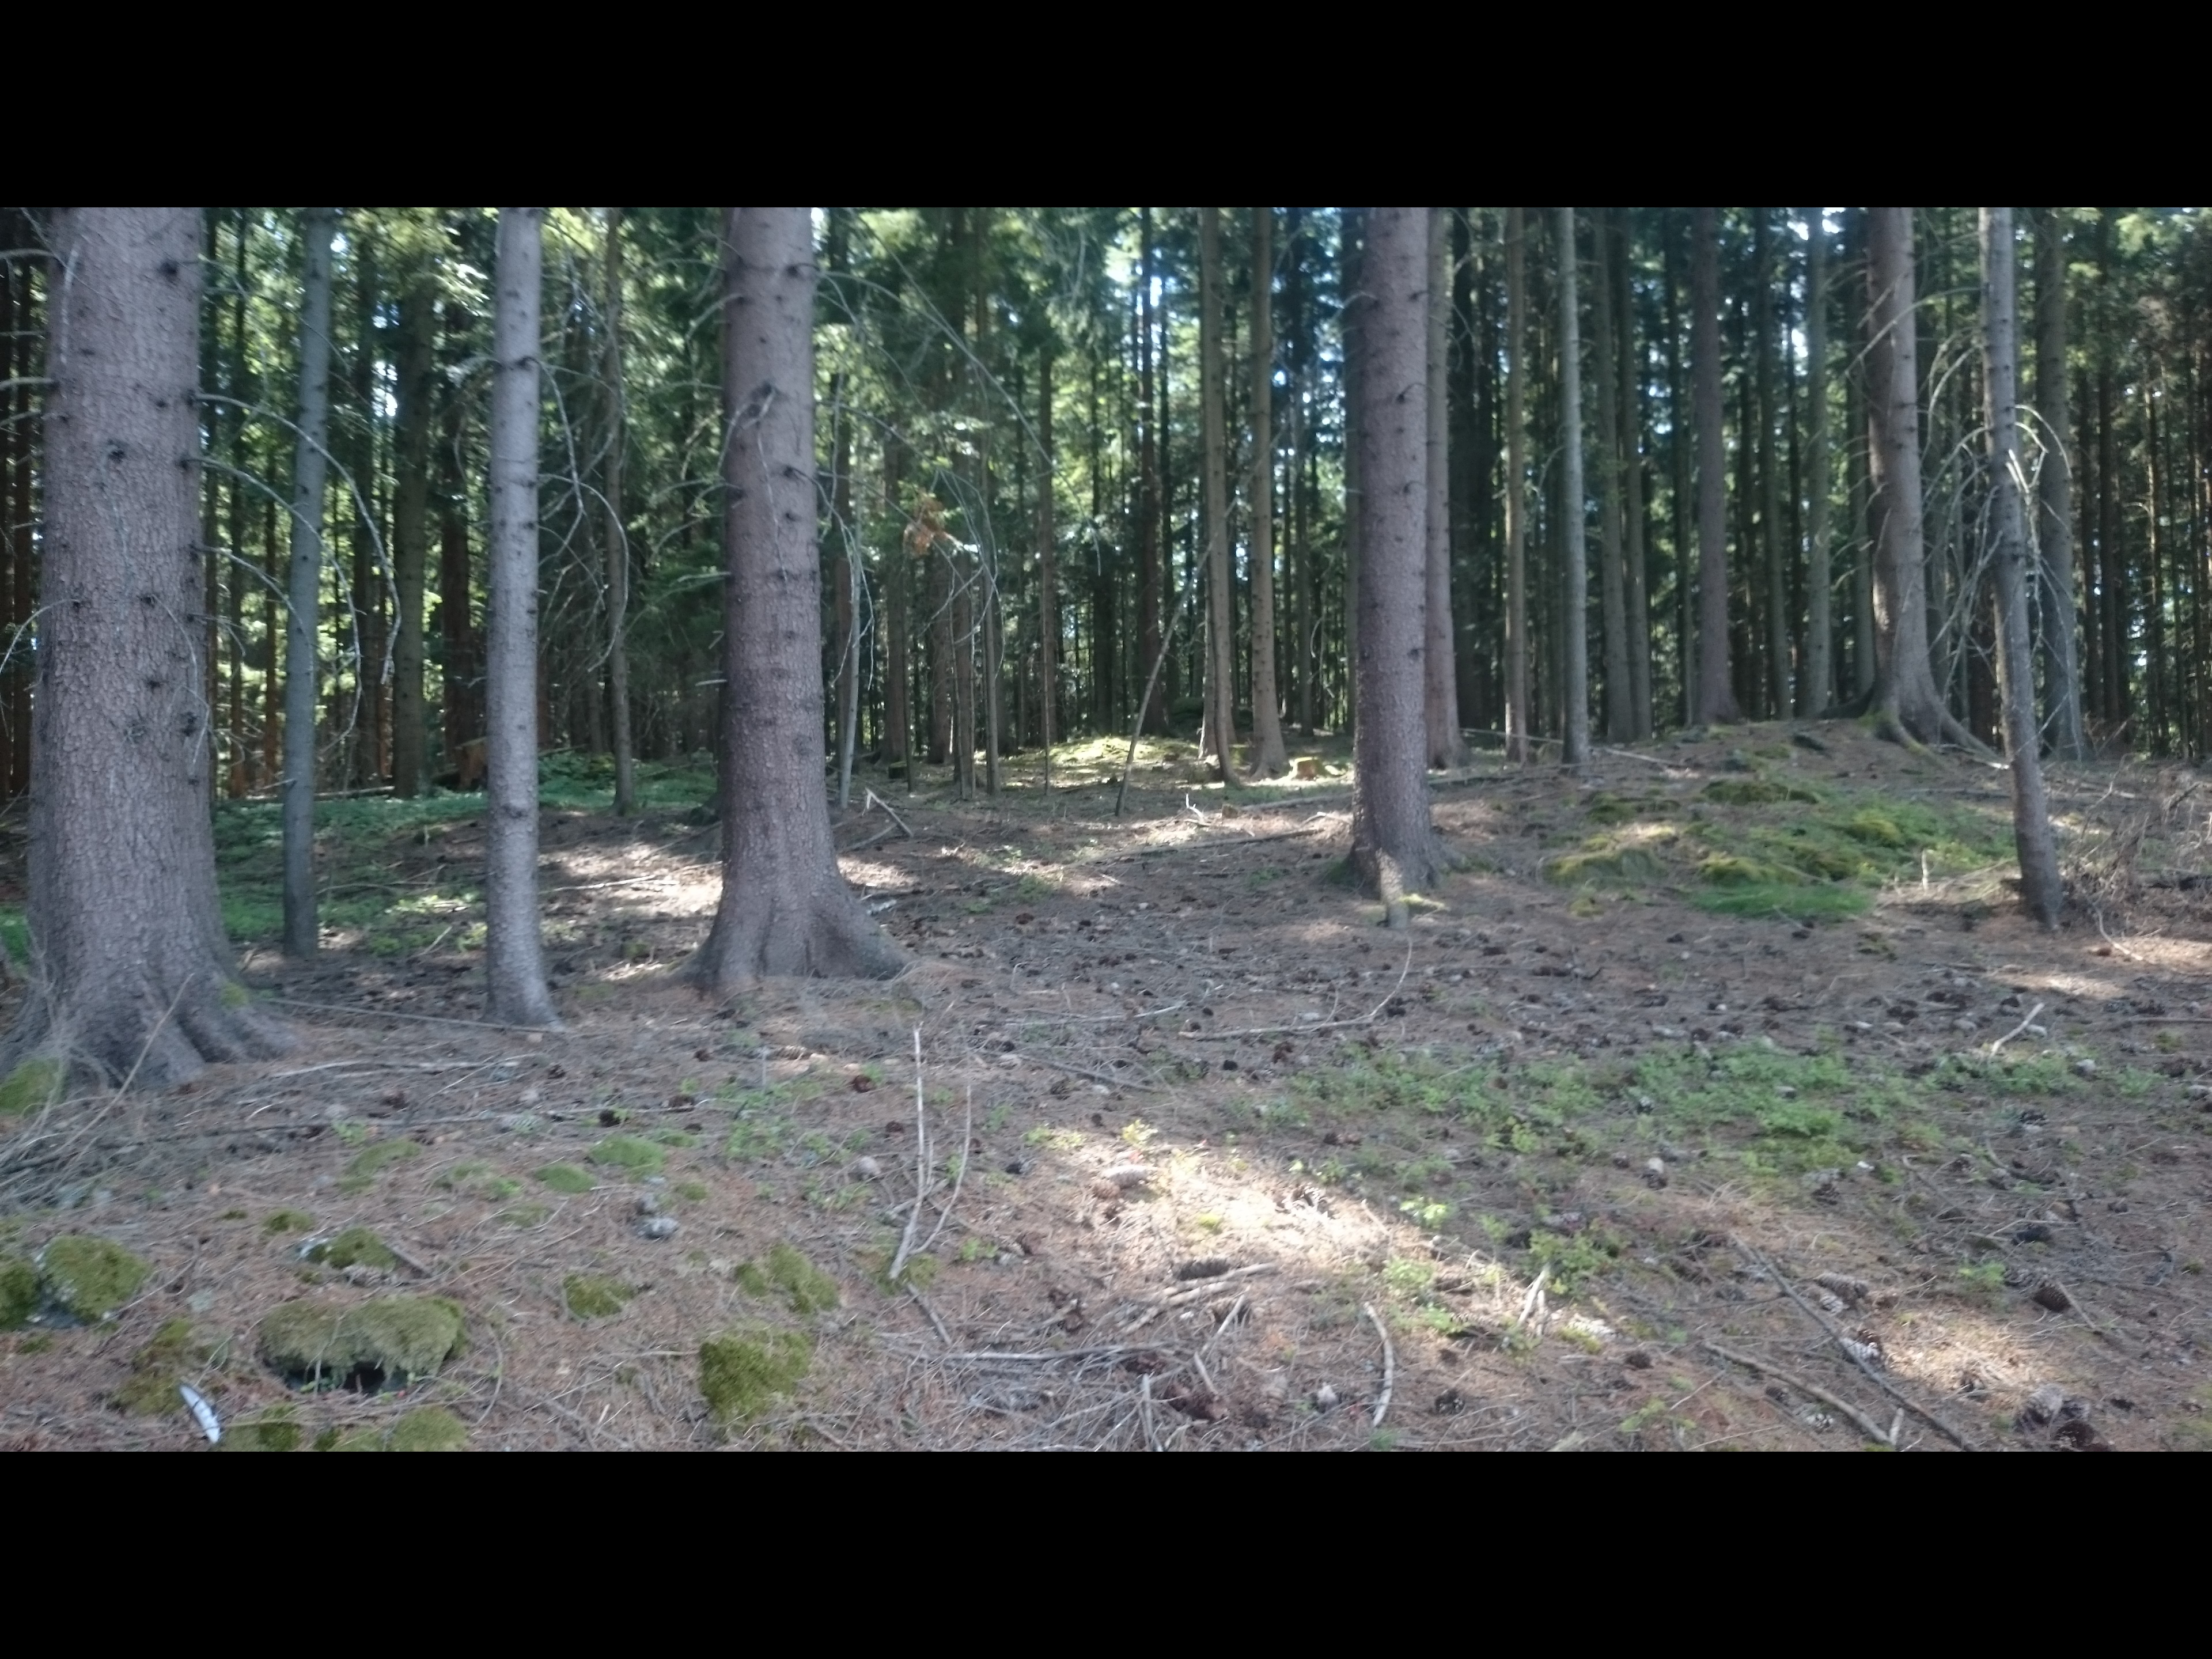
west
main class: Woodland
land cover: Spruce dominated coniferous woodland
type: hemiboreal forest and nemoral coniferous forest and mixed broadleaved-coniferous forest
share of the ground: > 75 %
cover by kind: coniferous forest trees 75 %, unconsolidated bare surface 20 %, herbaceous plants 5 %
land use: Forestry
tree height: > 5 m
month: July
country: AT
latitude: 48.6876
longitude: 14.9871
